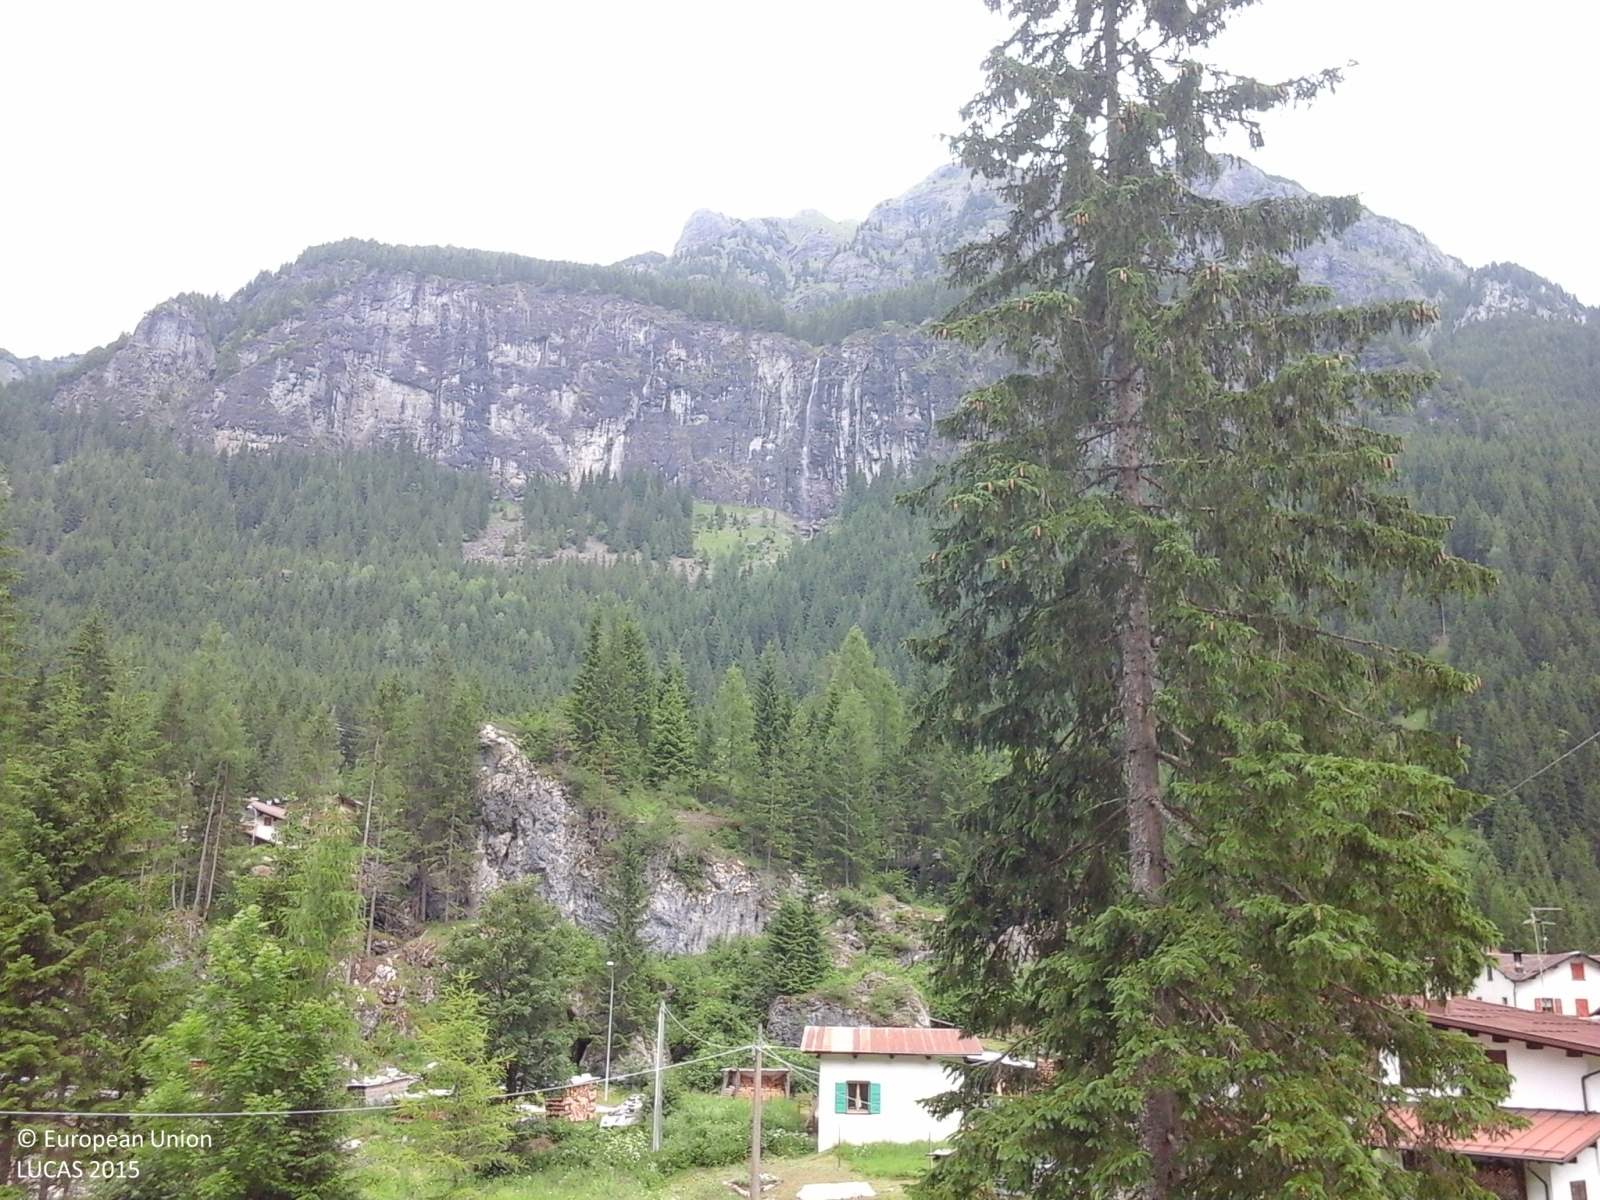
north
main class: Woodland
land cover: Spruce dominated coniferous woodland
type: alpine coniferous forest
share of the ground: > 75 %
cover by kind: coniferous forest trees 100 %
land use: Semi-natural and natural areas not in use
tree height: > 5 m
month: June
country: IT
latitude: 46.4233
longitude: 11.9625
